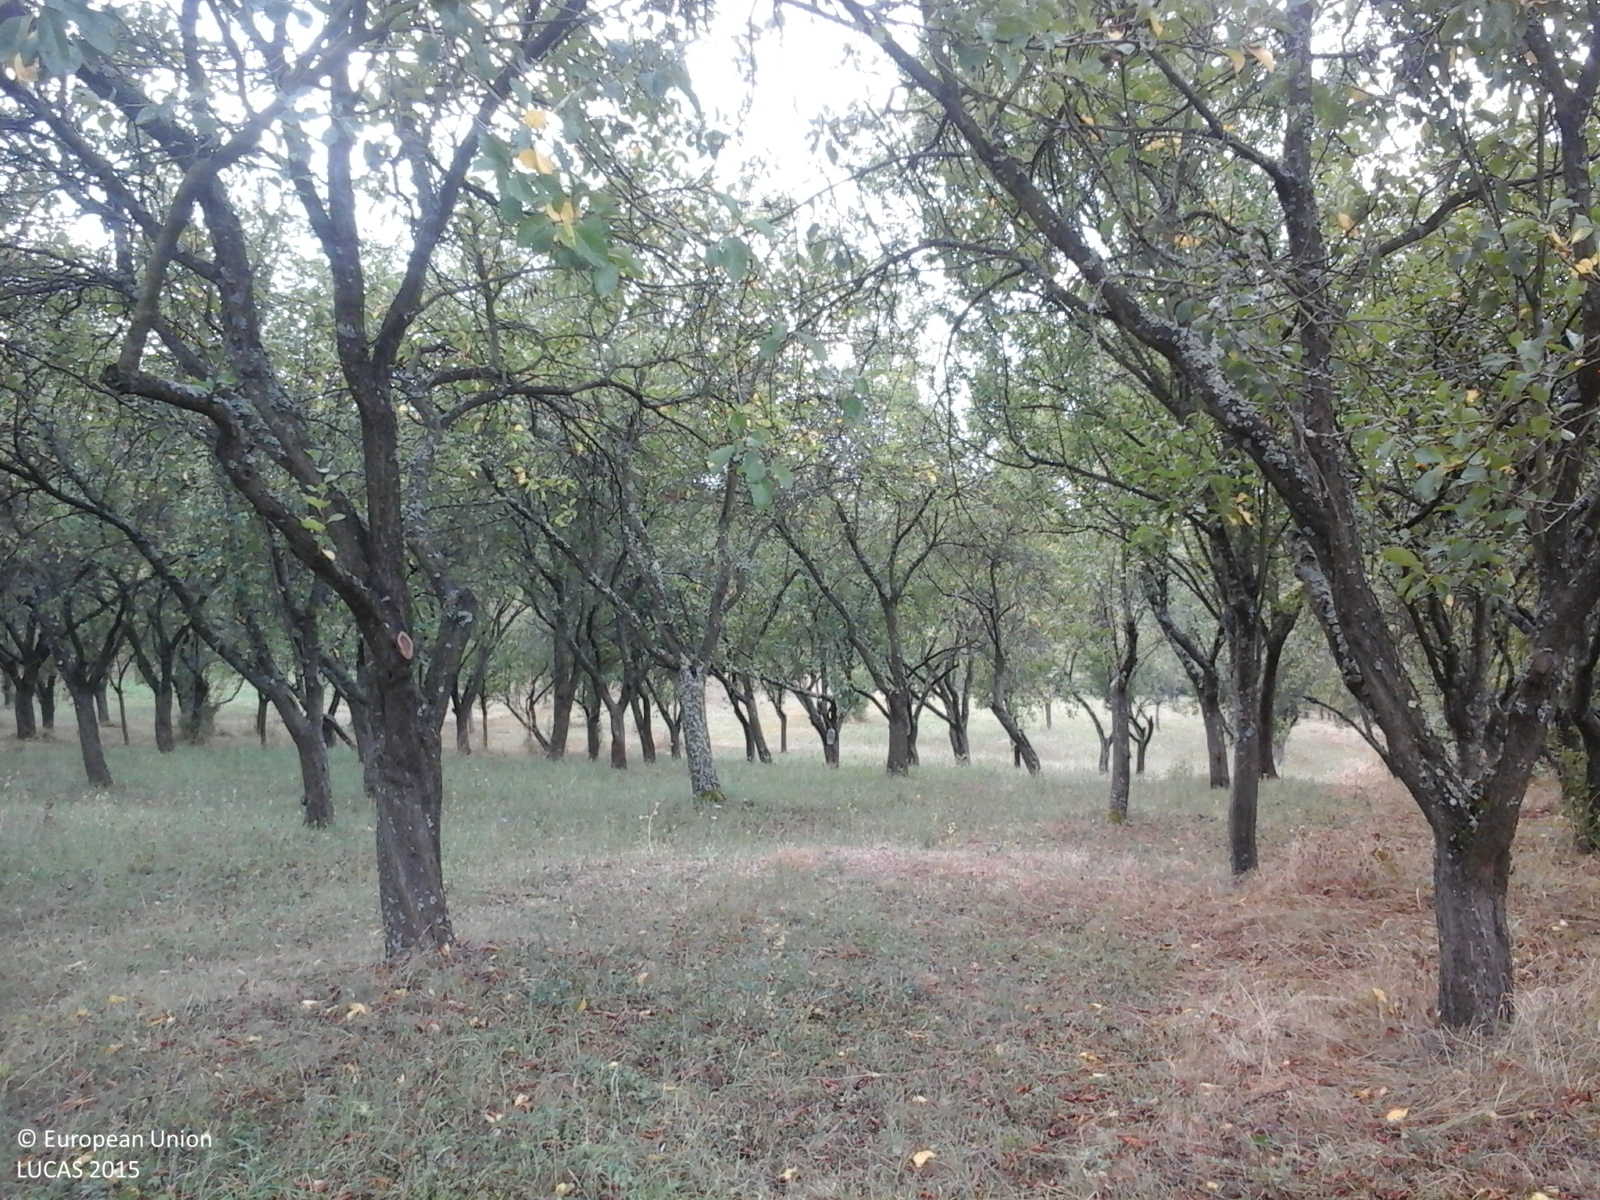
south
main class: Cropland
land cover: Apple fruit
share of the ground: 50 - 75 %
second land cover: Grassland without tree/shrub cover
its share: > 75 %
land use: Agriculture (excluding fallow land and kitchen gardens)
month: September
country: RO
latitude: 47.5737
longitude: 23.6228
